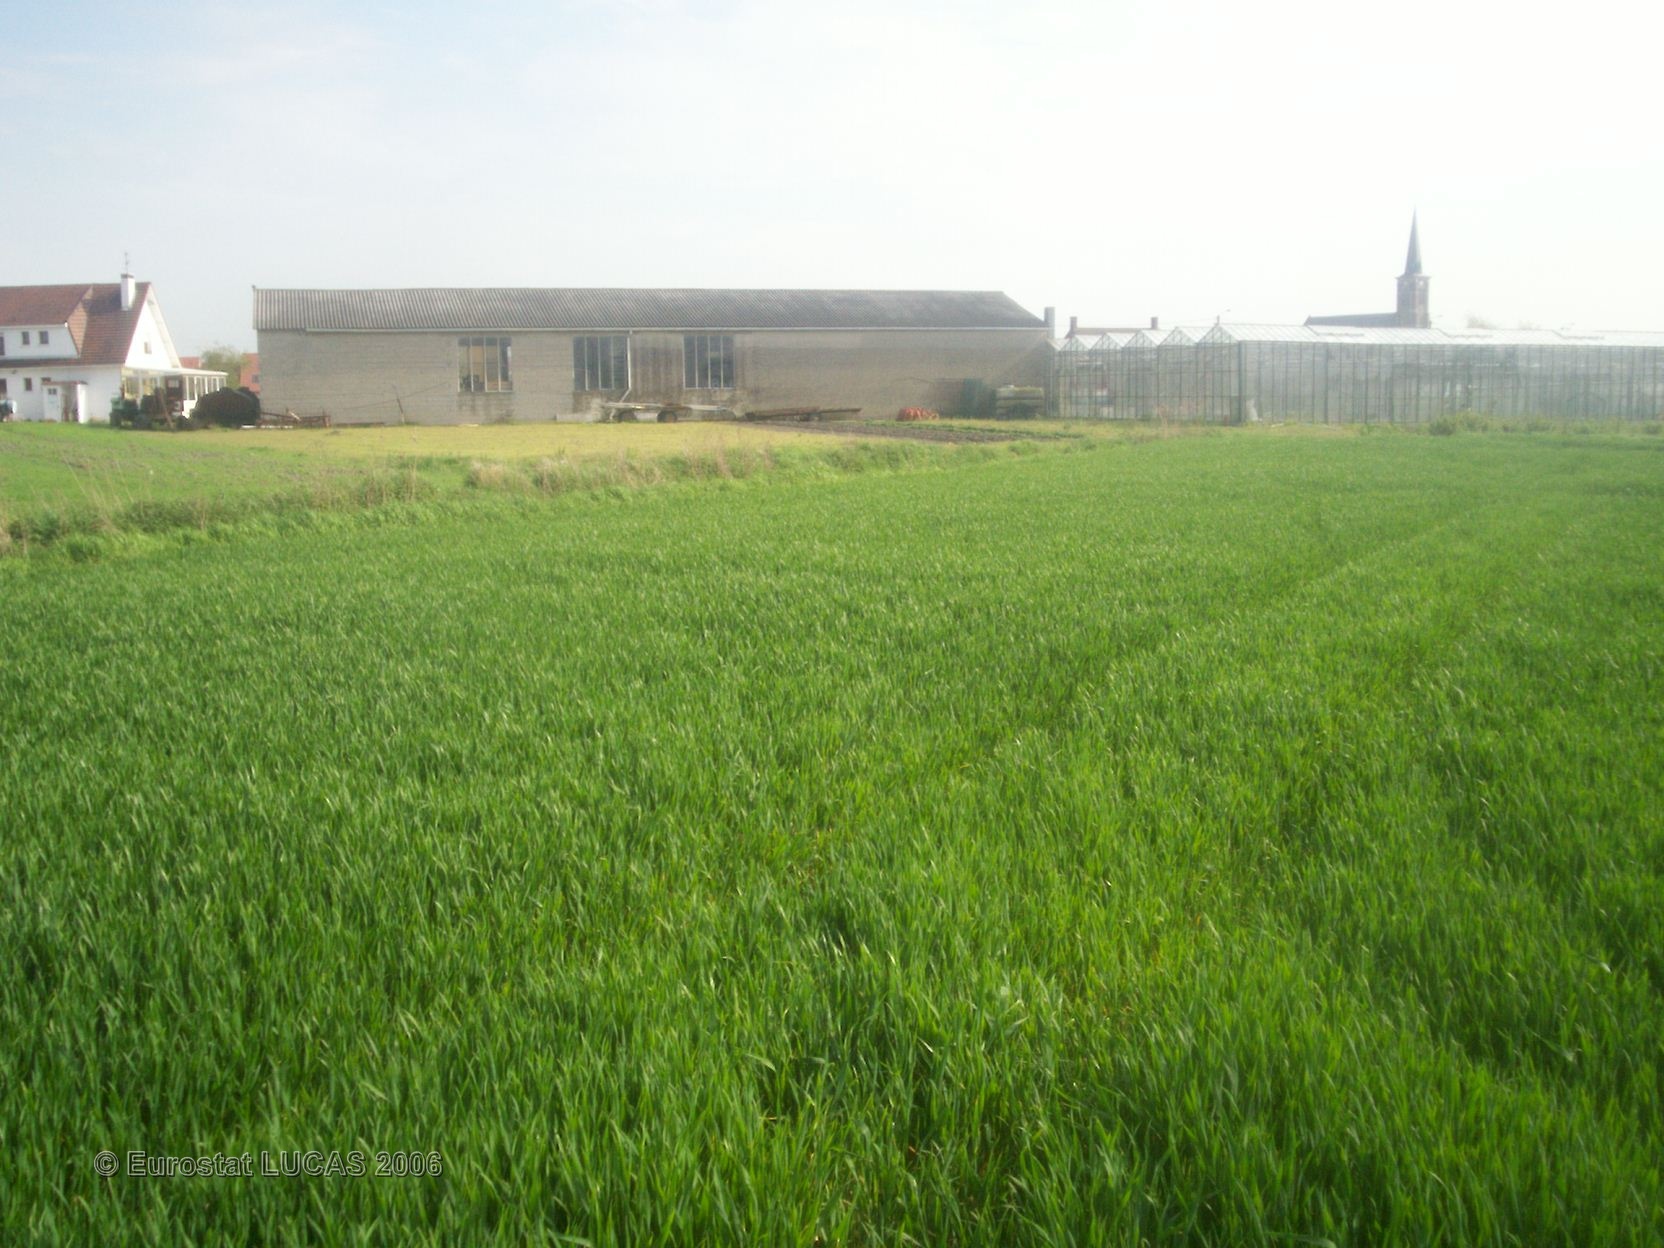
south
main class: Cropland
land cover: Common wheat
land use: Agriculture (excluding fallow land and kitchen gardens)
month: May
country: FR
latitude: 50.9813
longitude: 2.4519
